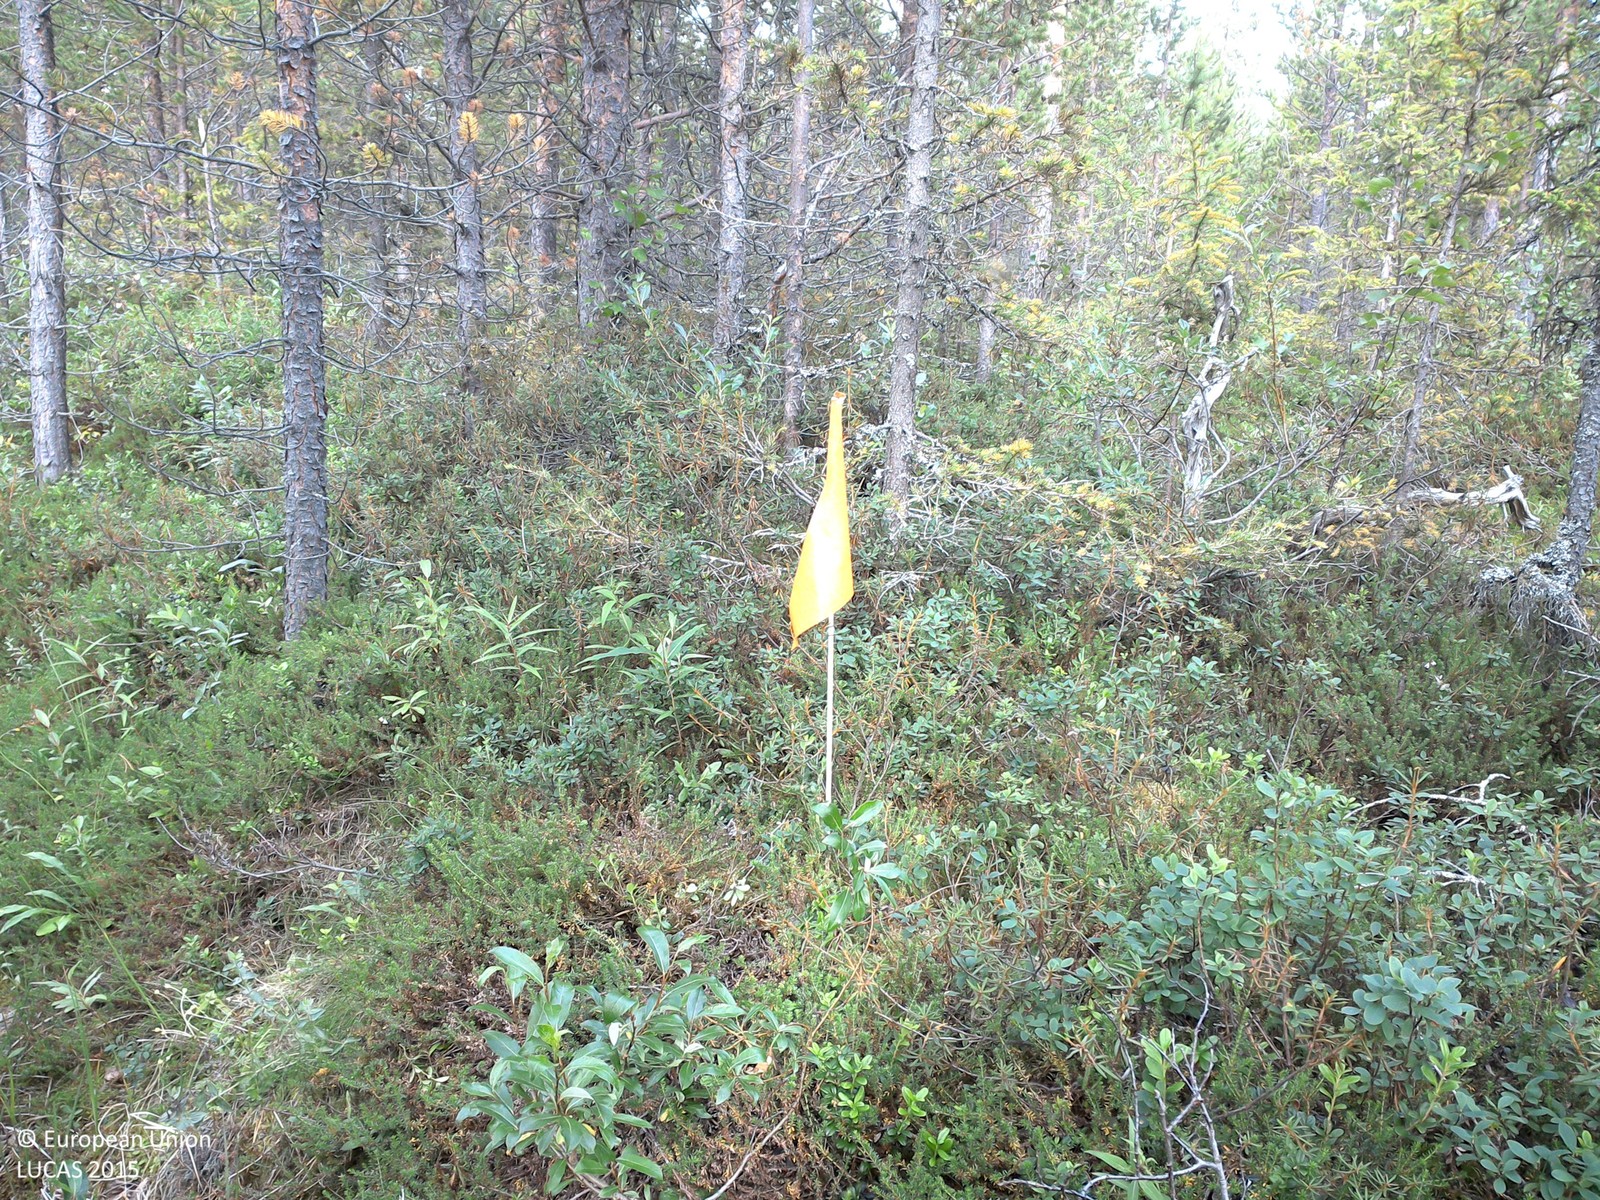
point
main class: Woodland
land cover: Pine dominated coniferous woodland
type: boreal forest
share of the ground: 25 - 50 %
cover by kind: shrubs 55 %, coniferous forest trees 30 %, lichens and mosses 10 %, broadleaved forest trees 5 %
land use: Forestry
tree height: < 5 m
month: August
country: SE
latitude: 67.8691
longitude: 20.5248
